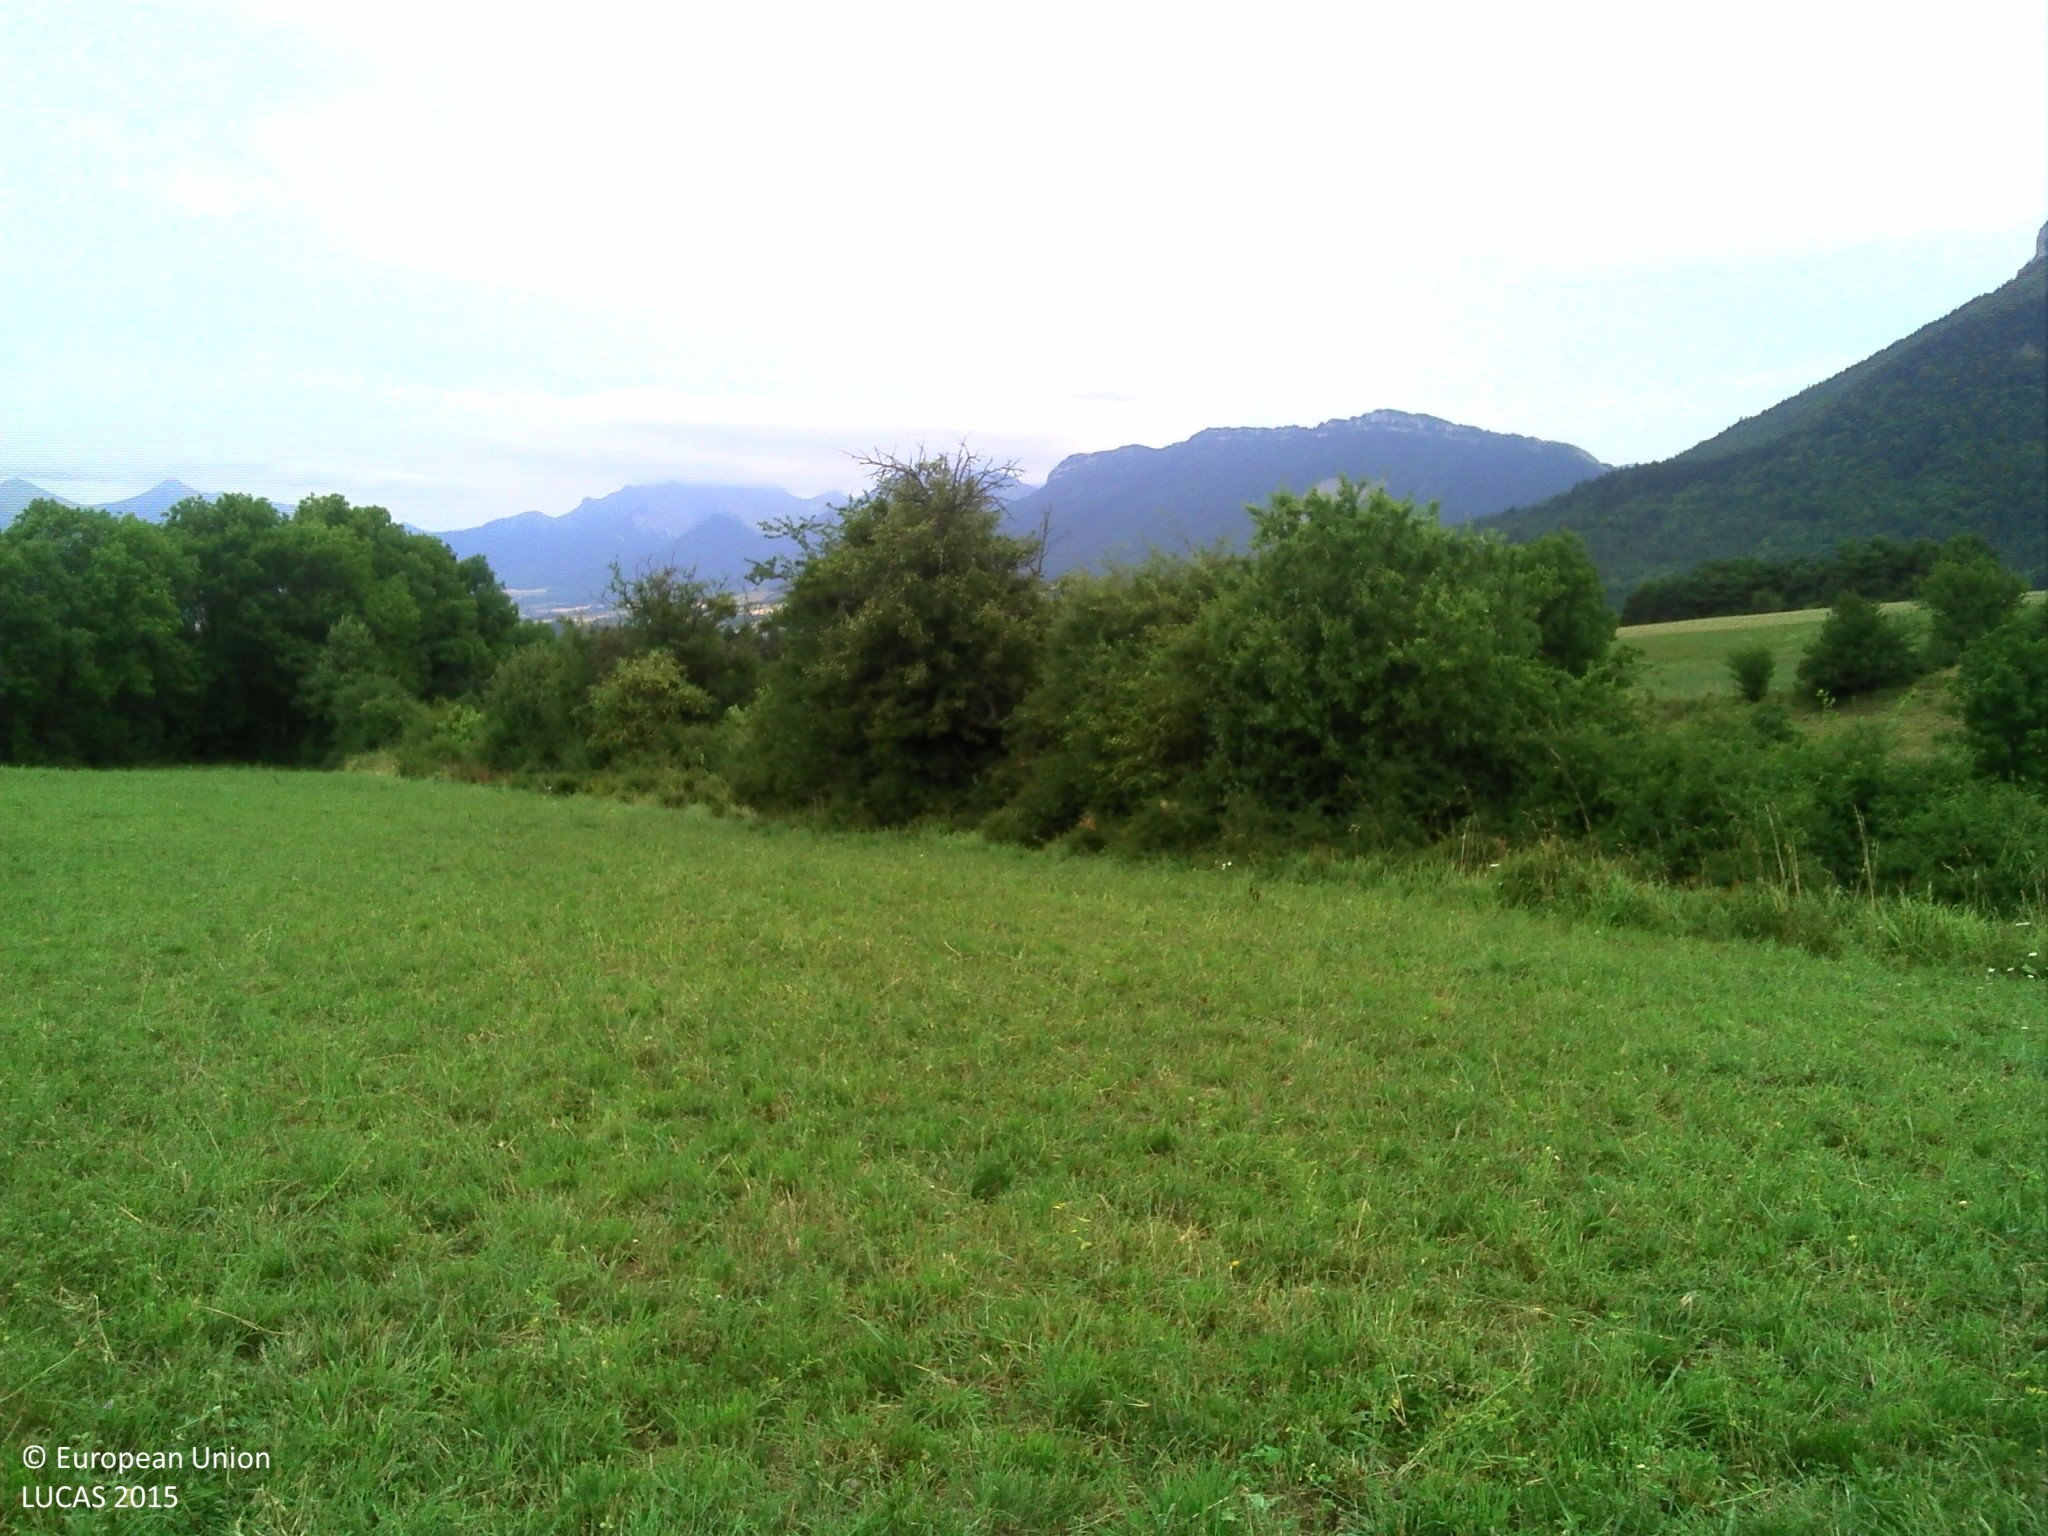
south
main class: Cropland
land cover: Temporary grasslands
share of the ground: > 75 %
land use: Agriculture (excluding fallow land and kitchen gardens)
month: July
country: FR
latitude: 44.8718
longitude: 5.6139
